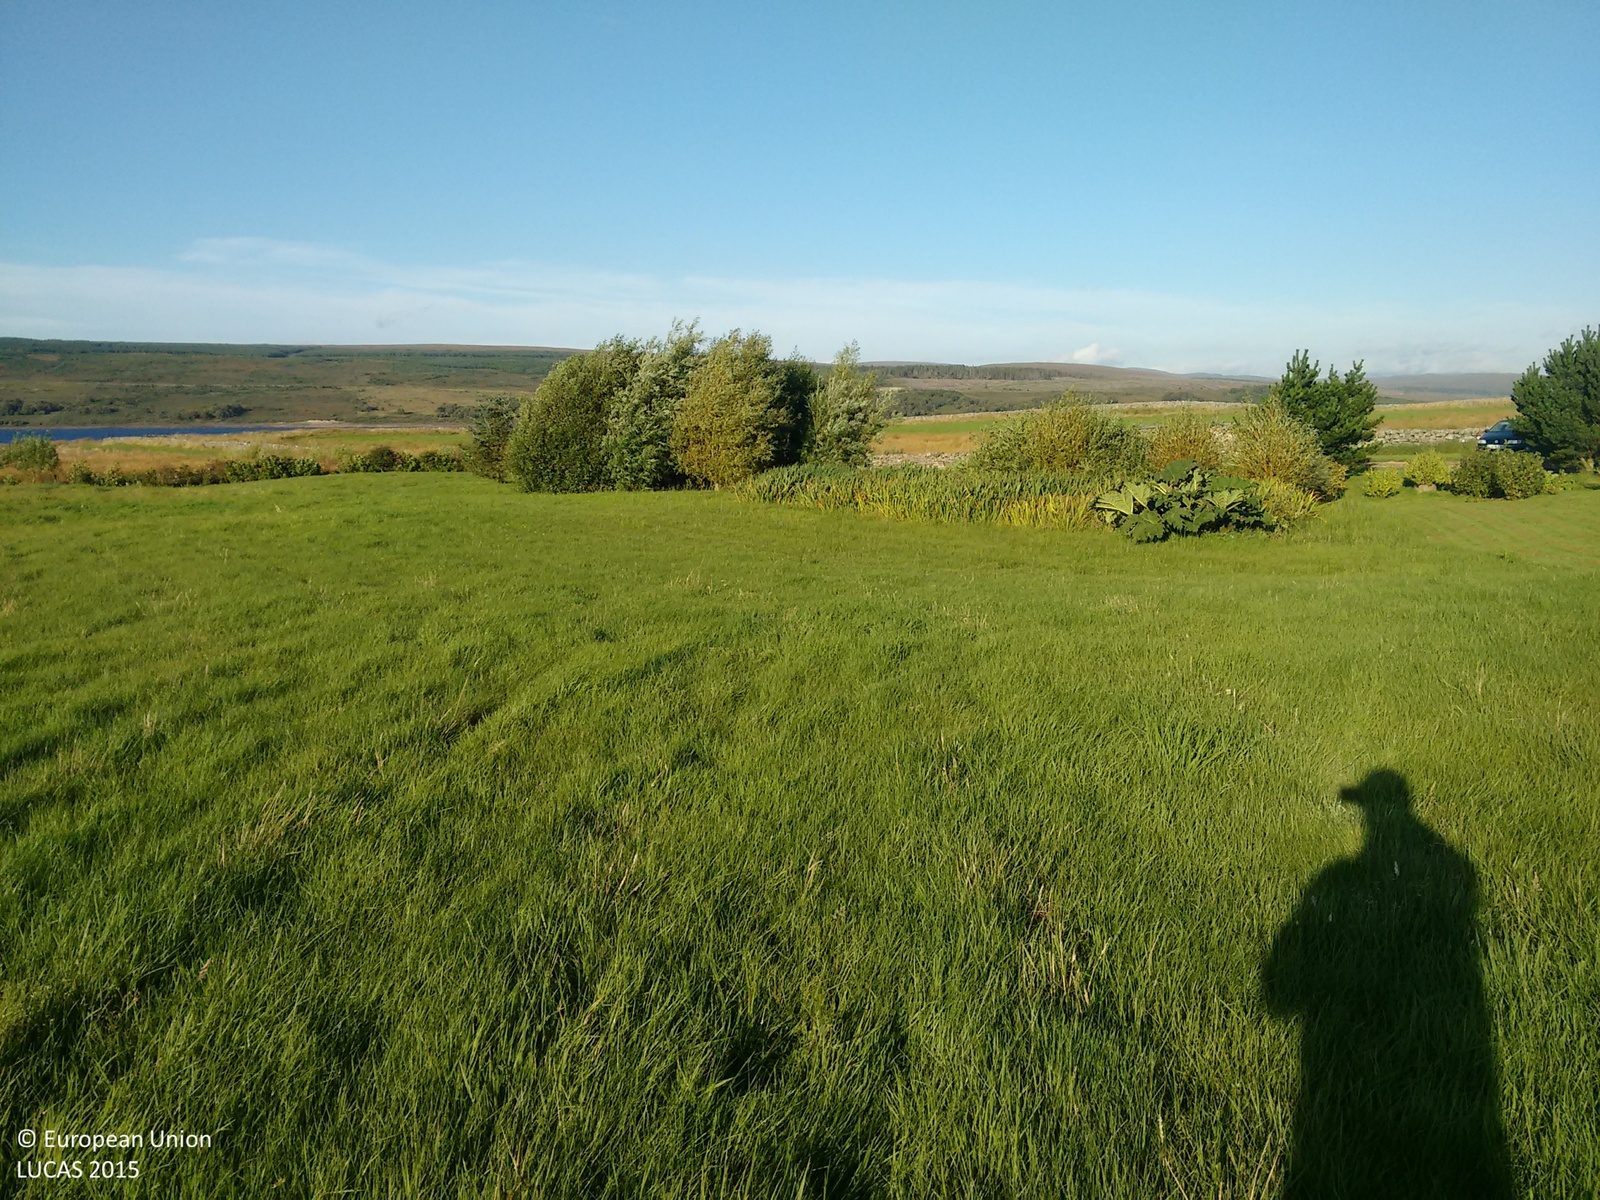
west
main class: Grassland
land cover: Grassland without tree/shrub cover
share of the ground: > 75 %
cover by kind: herbaceous plants 100 %
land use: Residential
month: September
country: GB
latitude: 58.0567
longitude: -4.4398
